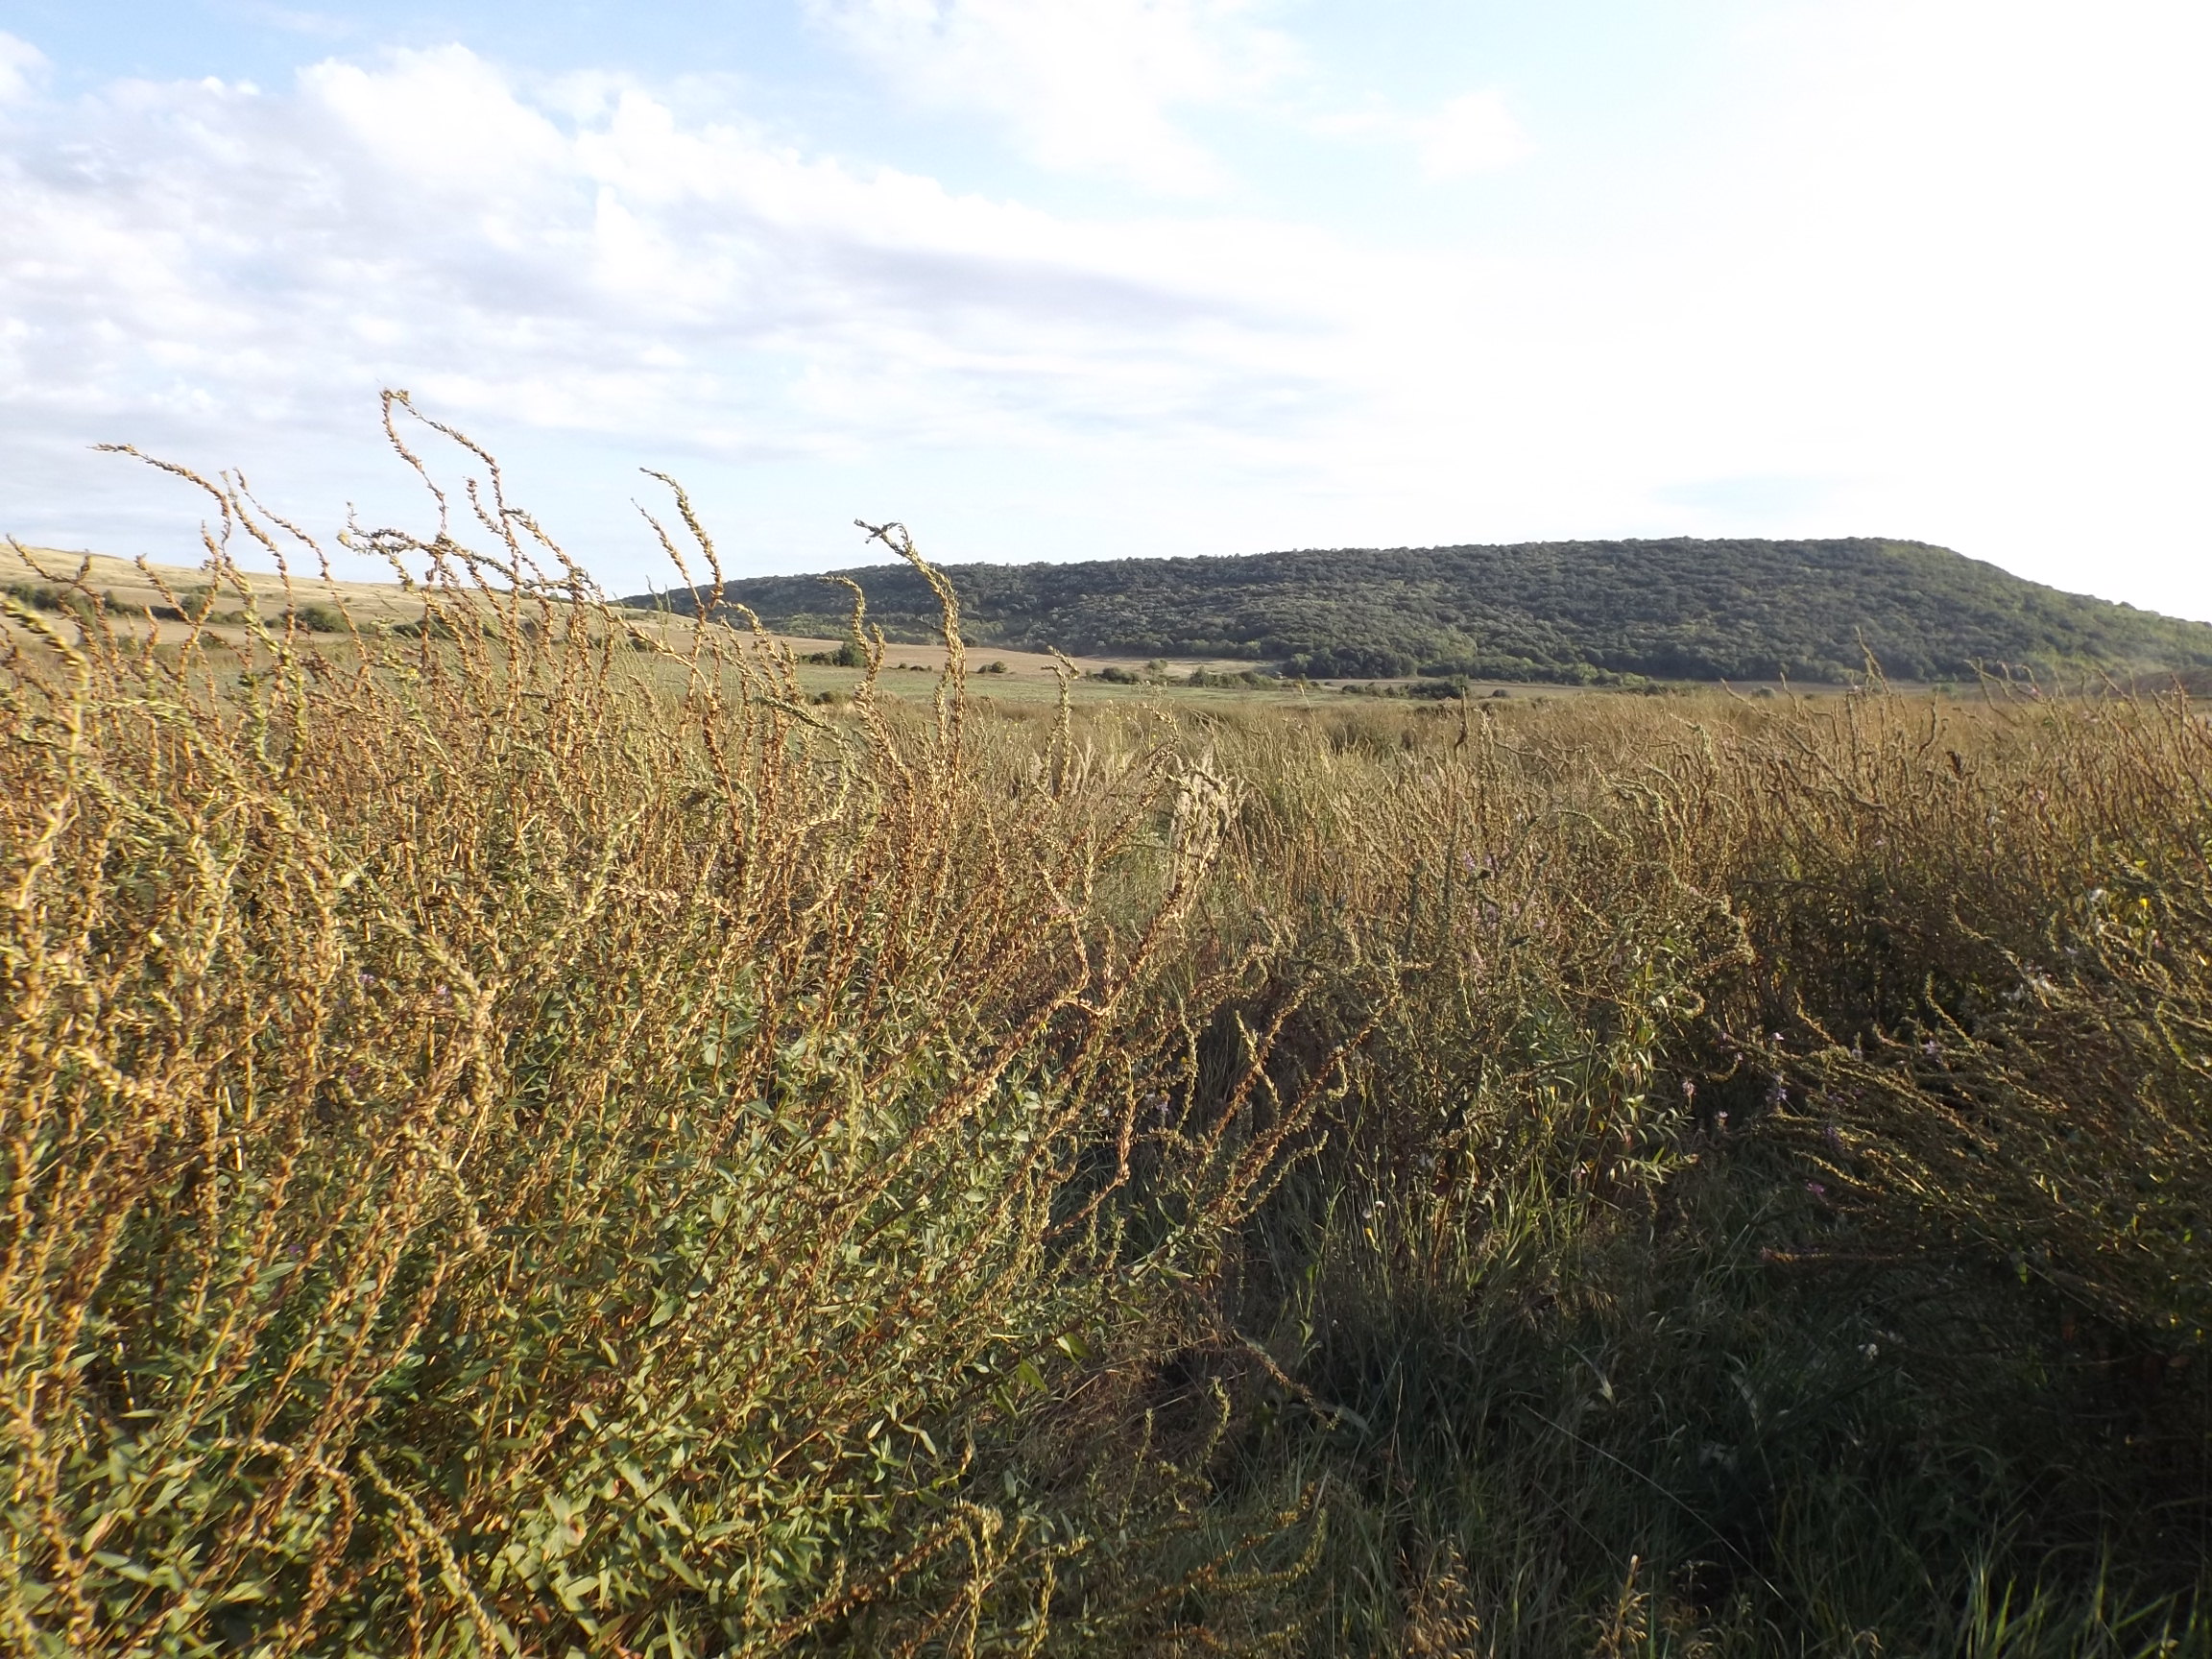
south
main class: Grassland
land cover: Spontaneously vegetated surfaces
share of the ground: > 75 %
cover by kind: herbaceous plants 95 %, shrubs 5 %
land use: Semi-natural and natural areas not in use
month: September
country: BG
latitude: 43.3657
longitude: 27.3902
